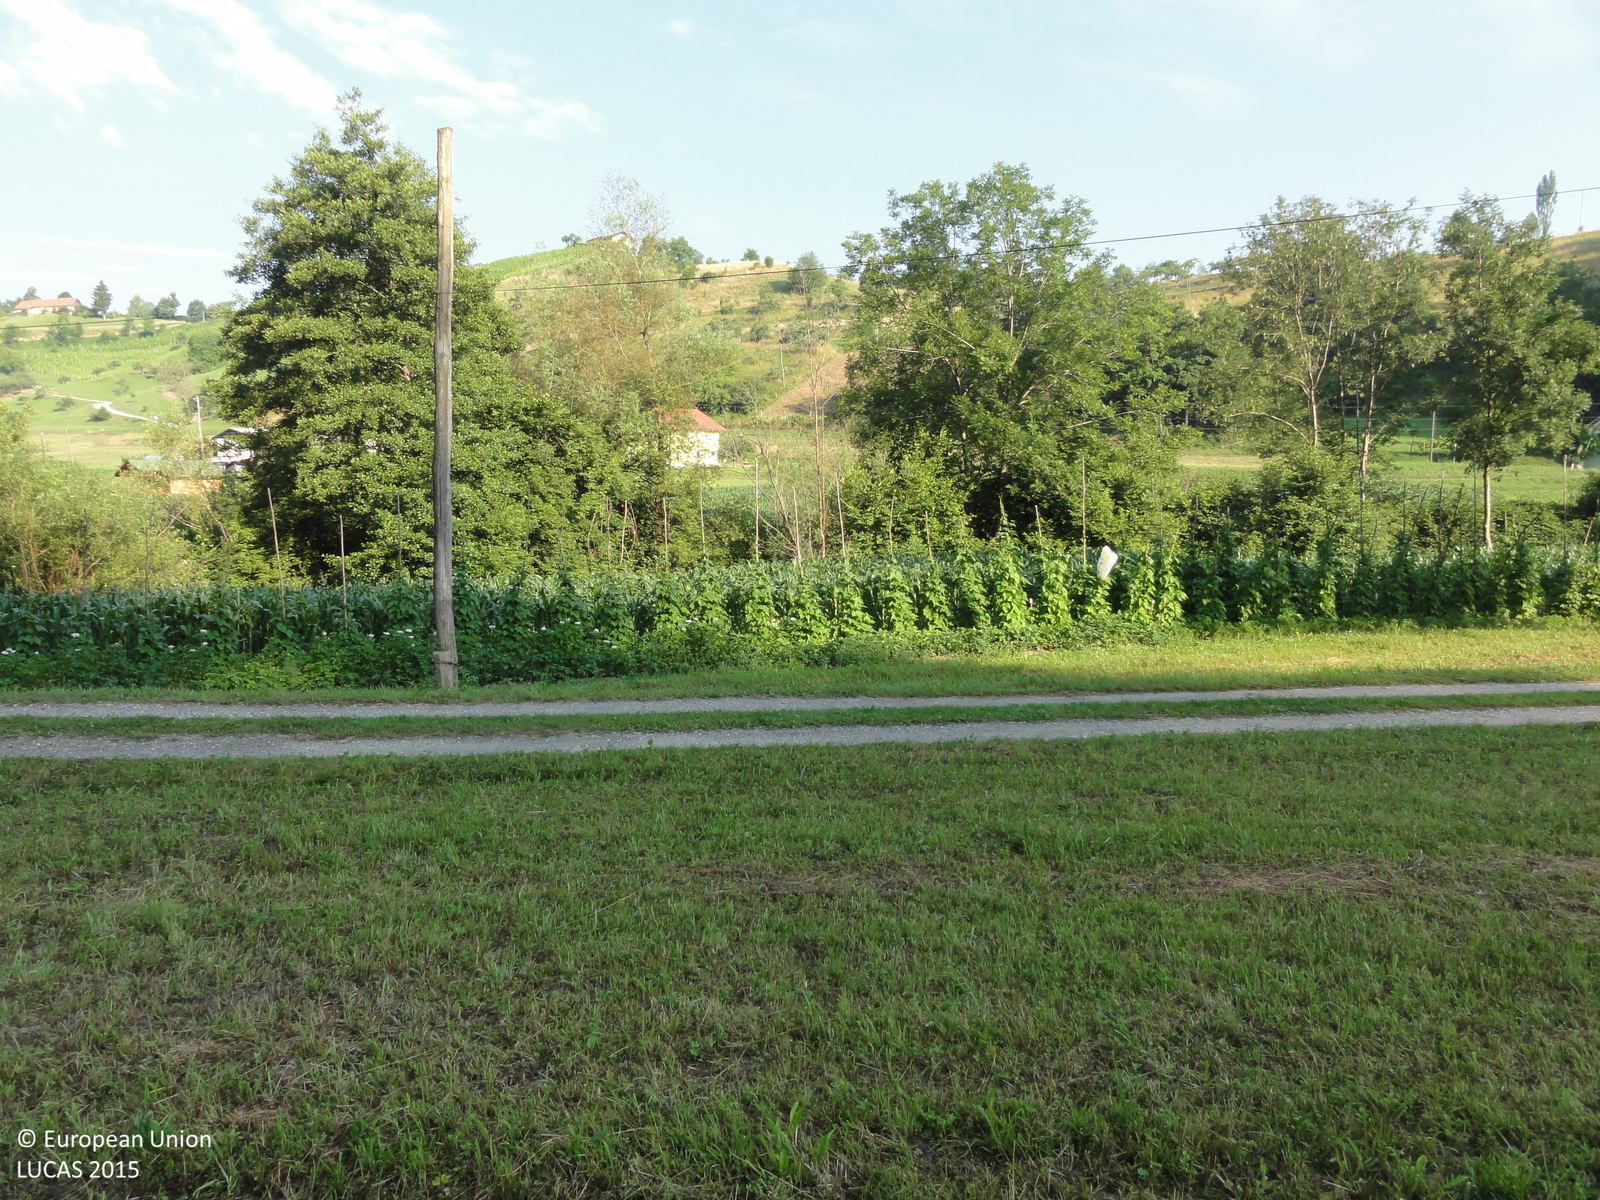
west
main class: Grassland
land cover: Grassland without tree/shrub cover
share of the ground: > 75 %
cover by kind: herbaceous plants 100 %
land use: Agriculture (excluding fallow land and kitchen gardens)
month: July
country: SI
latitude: 46.6389
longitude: 15.5773
